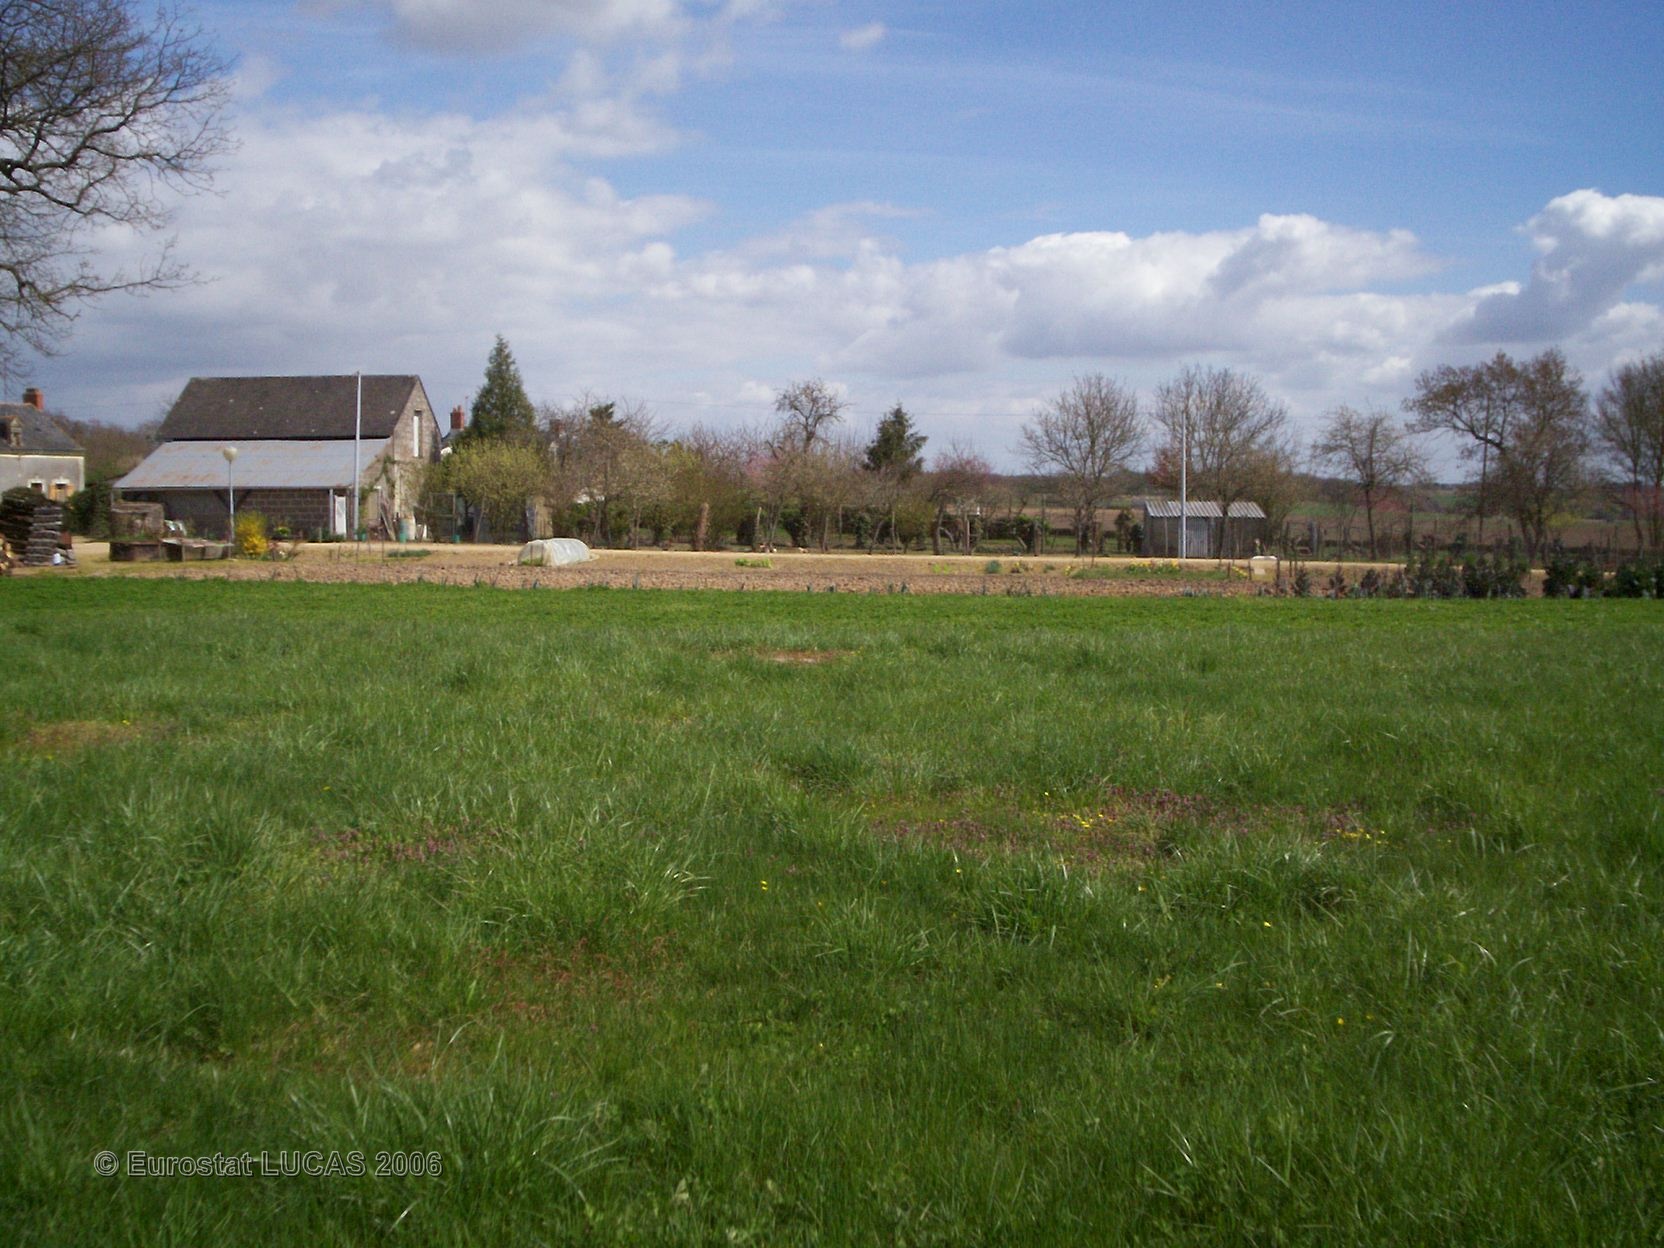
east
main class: Grassland
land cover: Grassland without tree/shrub cover
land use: Agriculture (excluding fallow land and kitchen gardens)
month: April
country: FR
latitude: 47.3676
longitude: -0.3979
